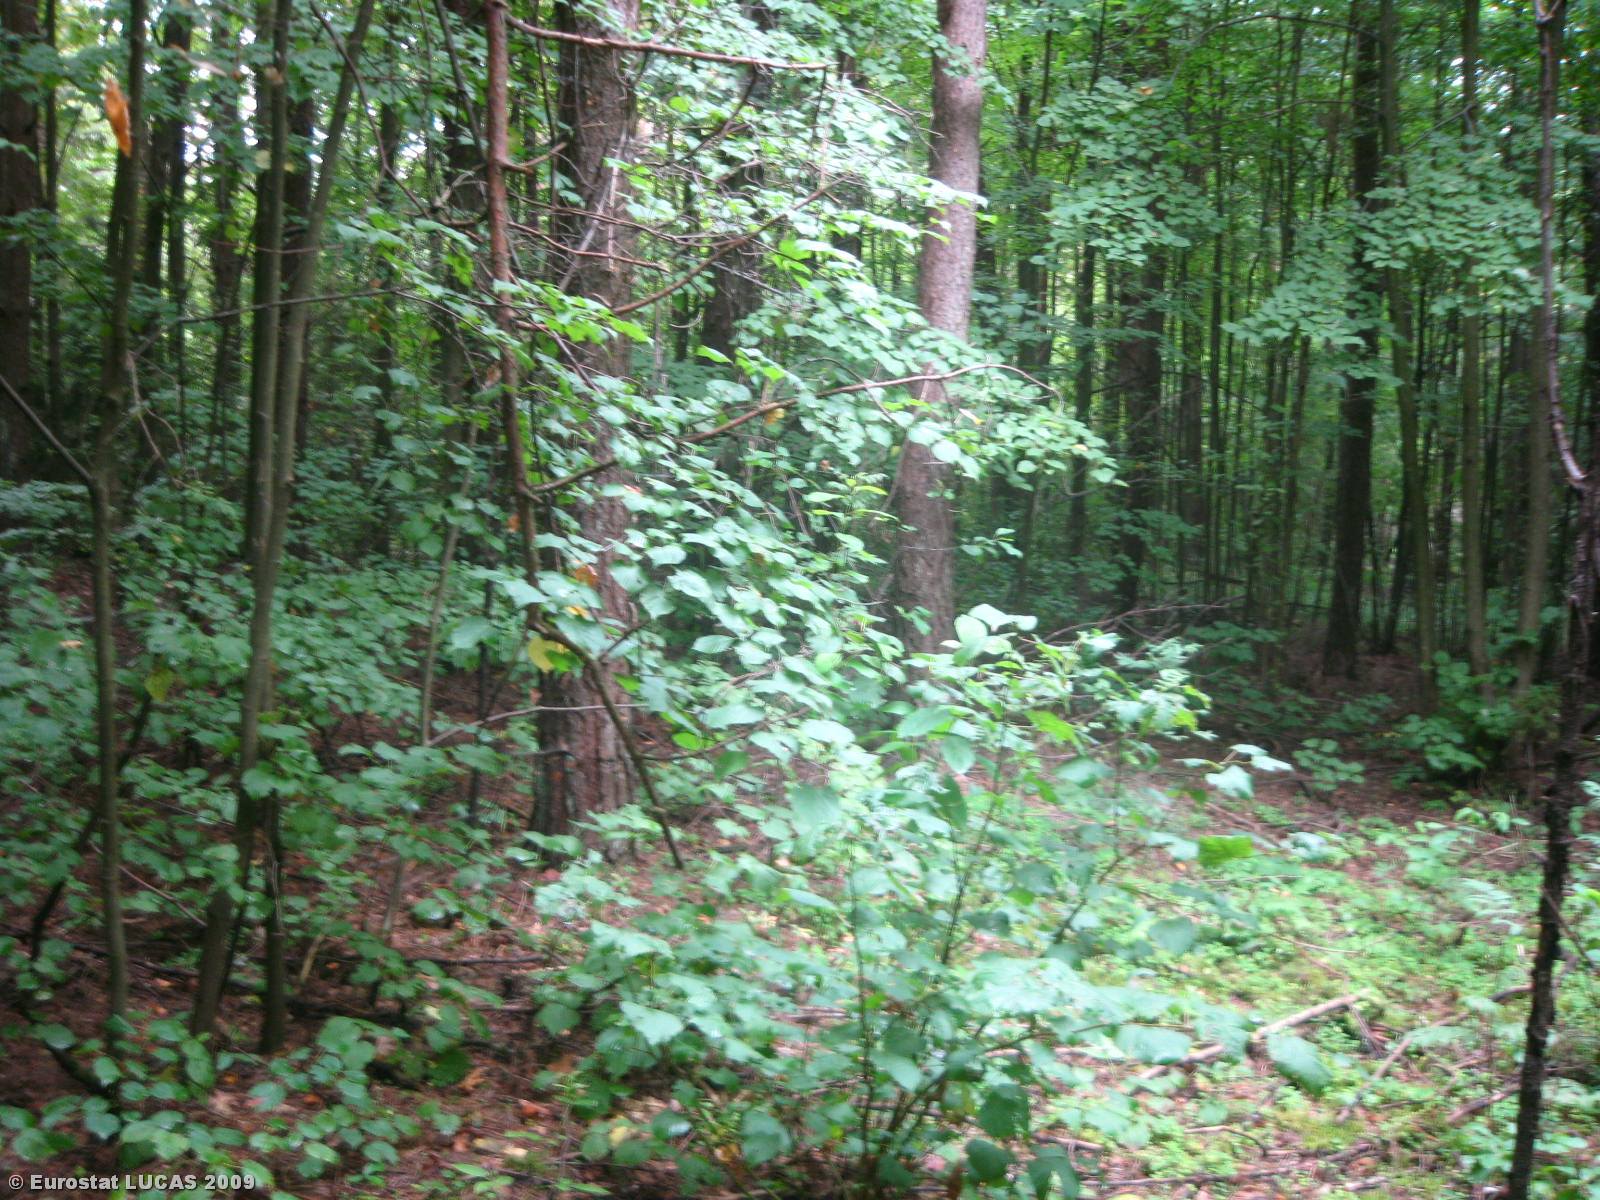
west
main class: Woodland
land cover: Mixed woodland
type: hemiboreal forest and nemoral coniferous forest and mixed broadleaved-coniferous forest
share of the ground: > 75 %
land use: Forestry
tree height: > 5 m
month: July
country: LT
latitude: 55.0196
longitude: 23.6119
